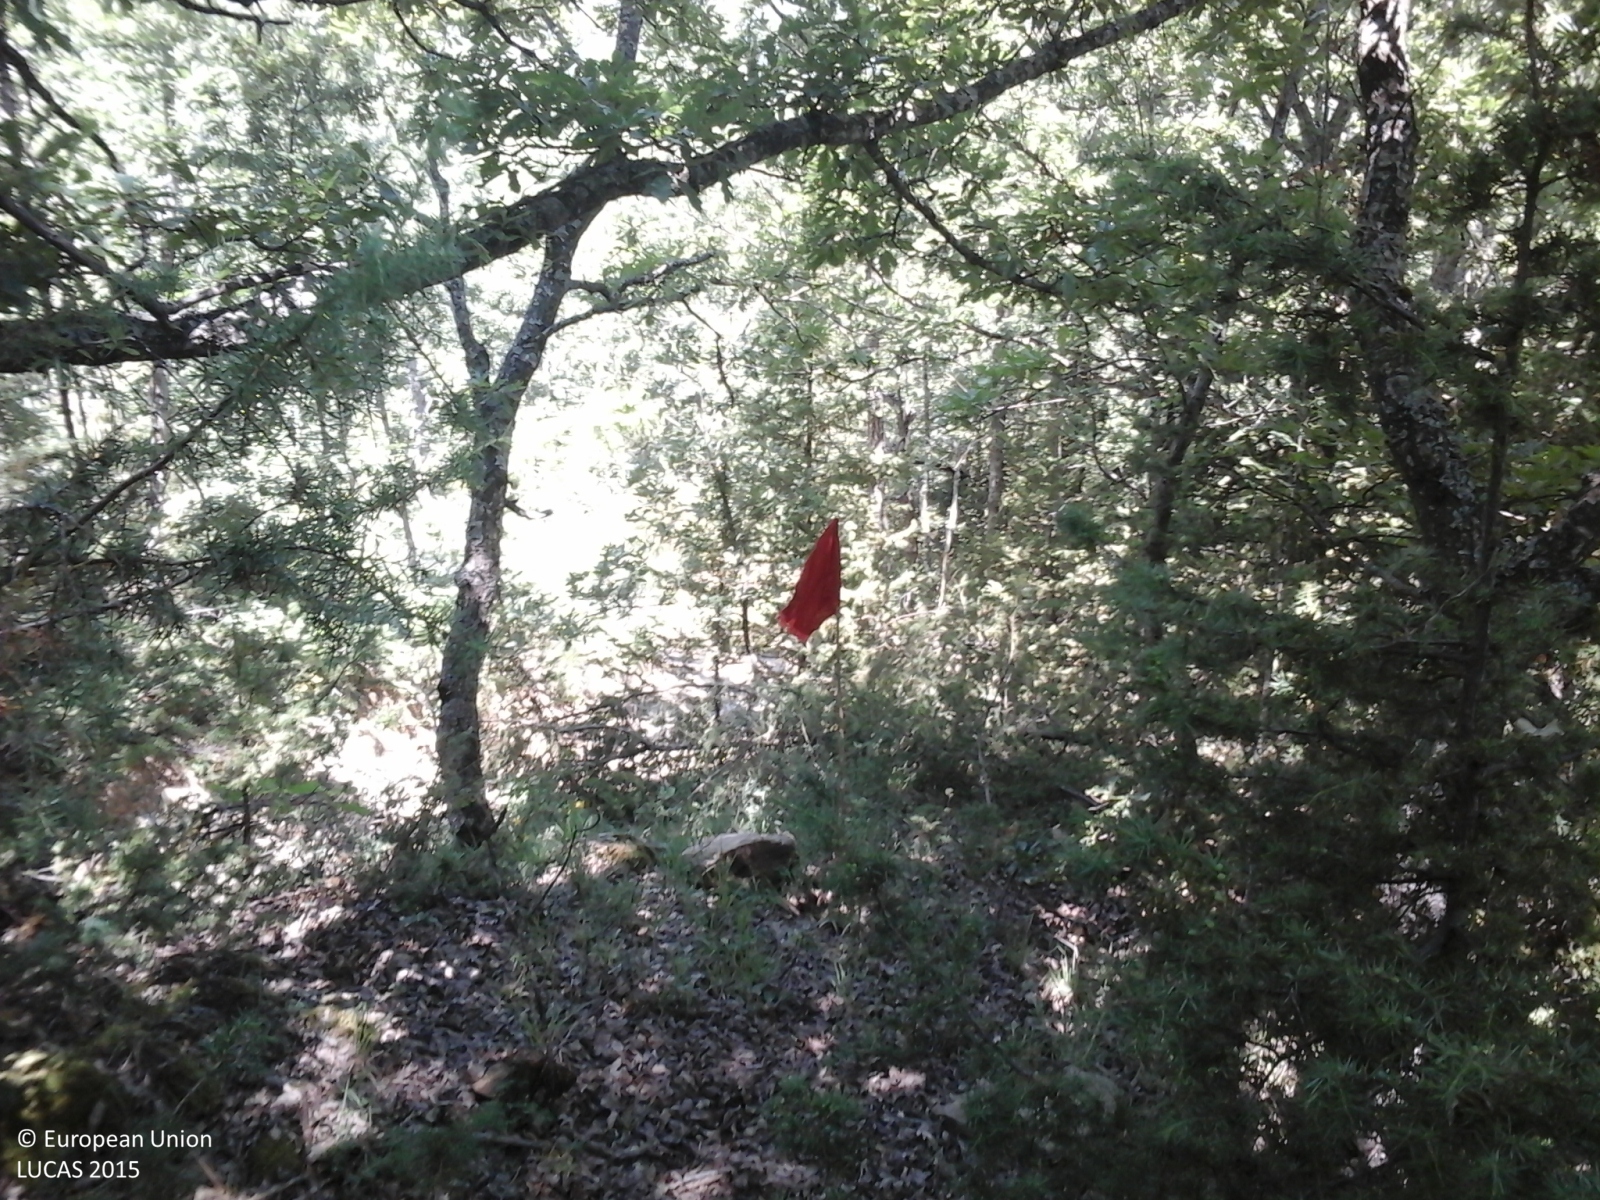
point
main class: Woodland
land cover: Broadleaved woodland
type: thermophilous deciduous forest
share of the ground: > 75 %
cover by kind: broadleaved forest trees 100 %
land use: Forestry
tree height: > 5 m
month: June
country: IT
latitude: 42.7284
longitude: 13.2512
